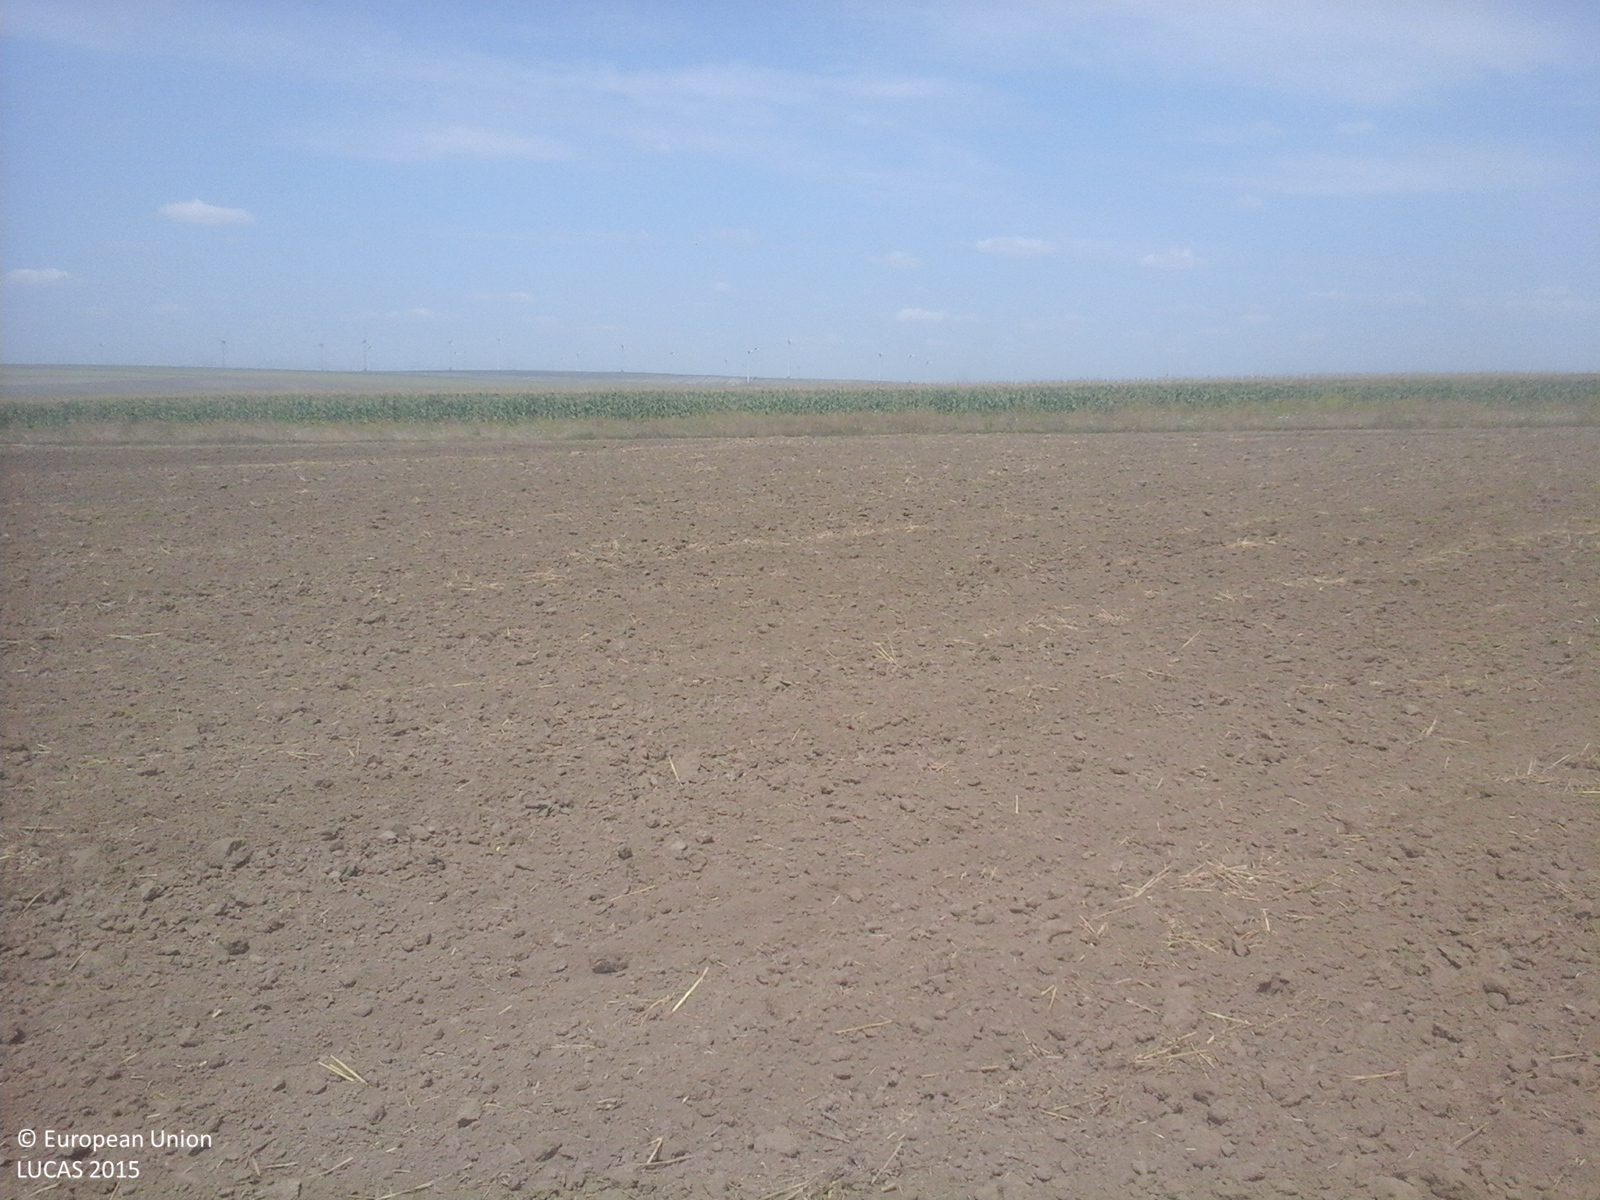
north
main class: Cropland
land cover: Common wheat
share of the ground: < 10 %
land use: Agriculture (excluding fallow land and kitchen gardens)
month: August
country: RO
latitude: 44.7248
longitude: 28.2611
